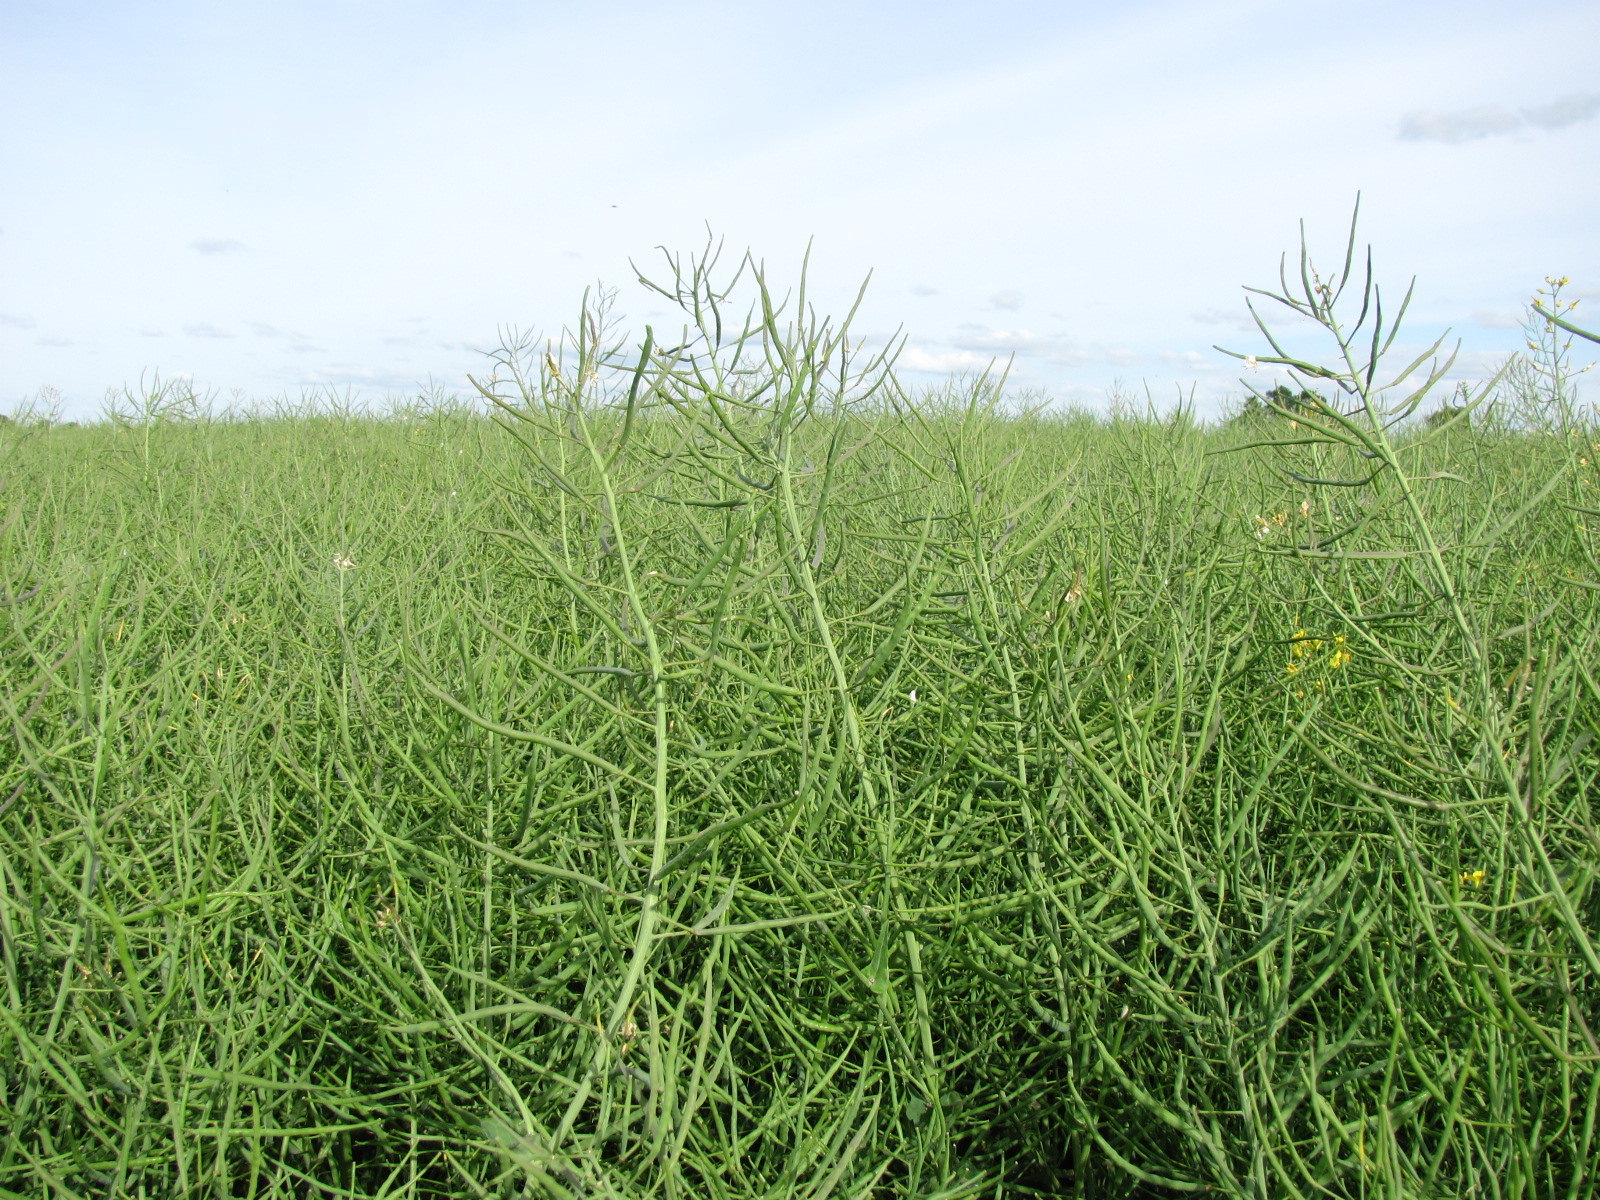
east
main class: Cropland
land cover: Rape and turnip rape
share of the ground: > 75 %
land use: Agriculture (excluding fallow land and kitchen gardens)
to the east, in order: Rape and turnip rape
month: June
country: LV
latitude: 56.5667
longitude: 23.8329
